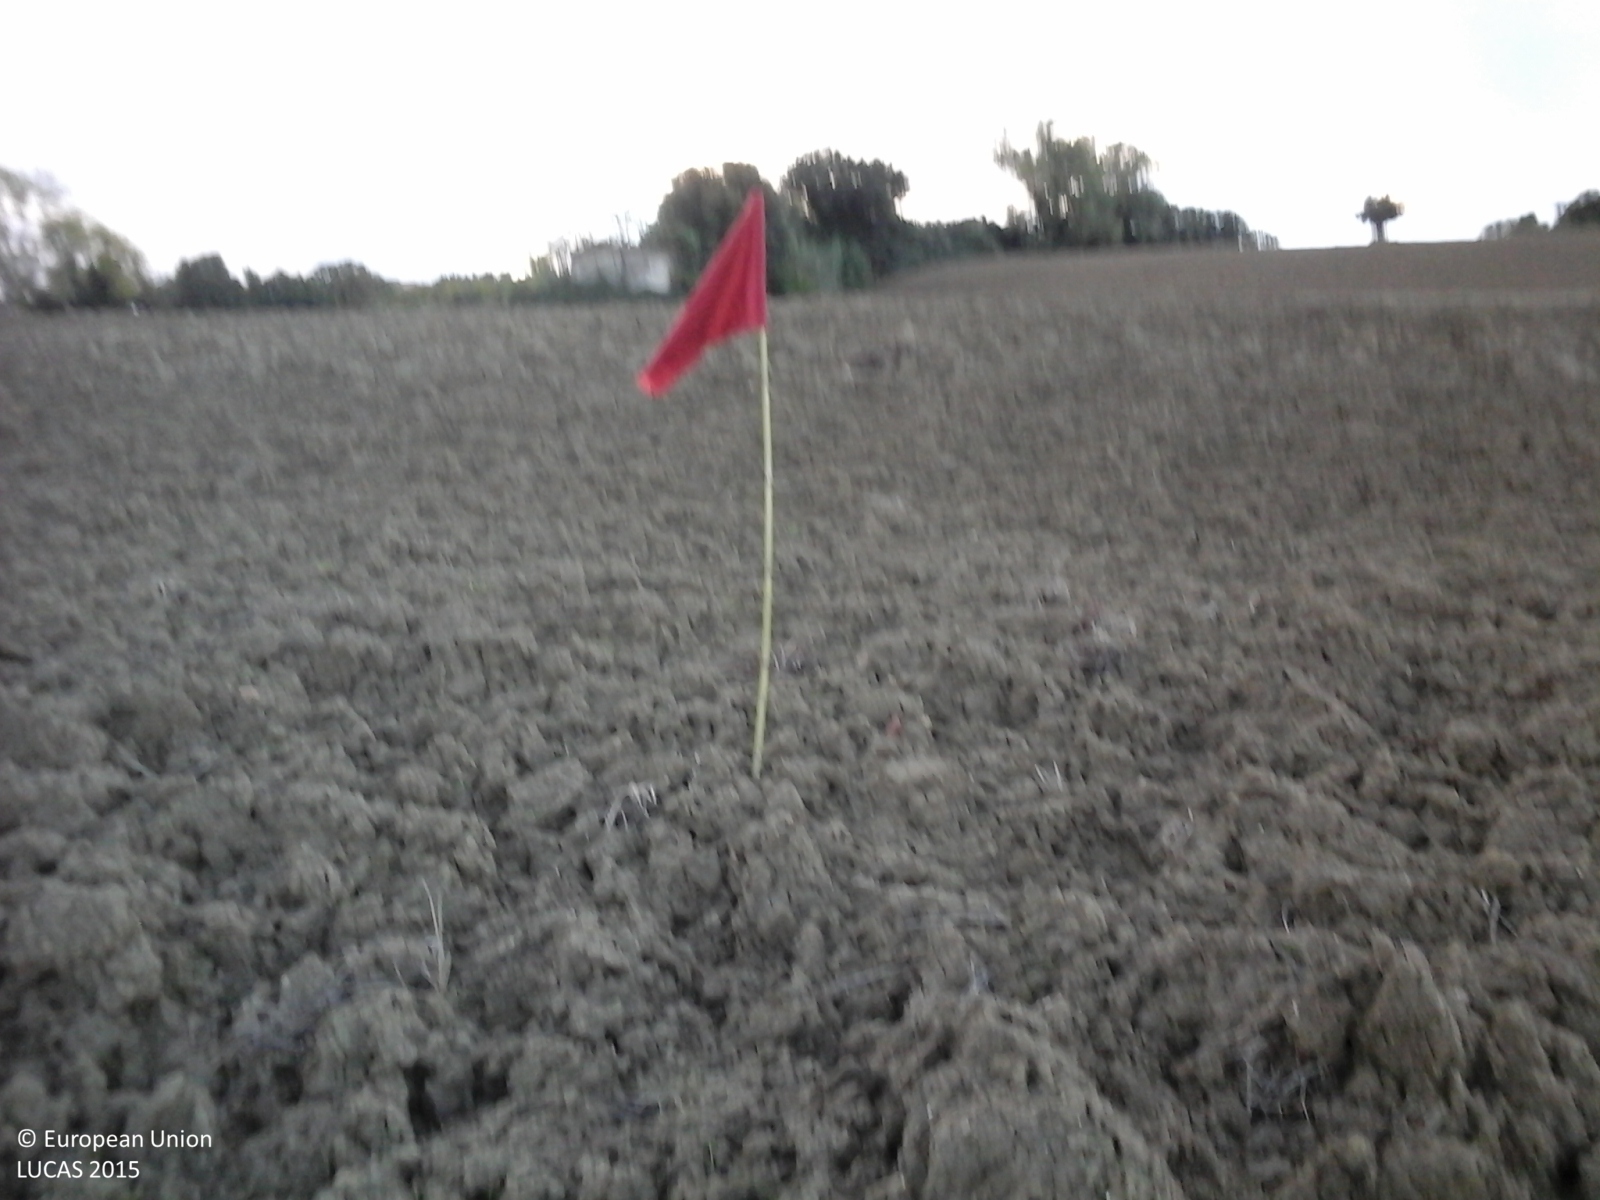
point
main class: Cropland
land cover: Durum wheat
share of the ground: < 10 %
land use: Agriculture (excluding fallow land and kitchen gardens)
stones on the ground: < 10 %
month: October
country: IT
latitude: 43.5963
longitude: 13.2252
